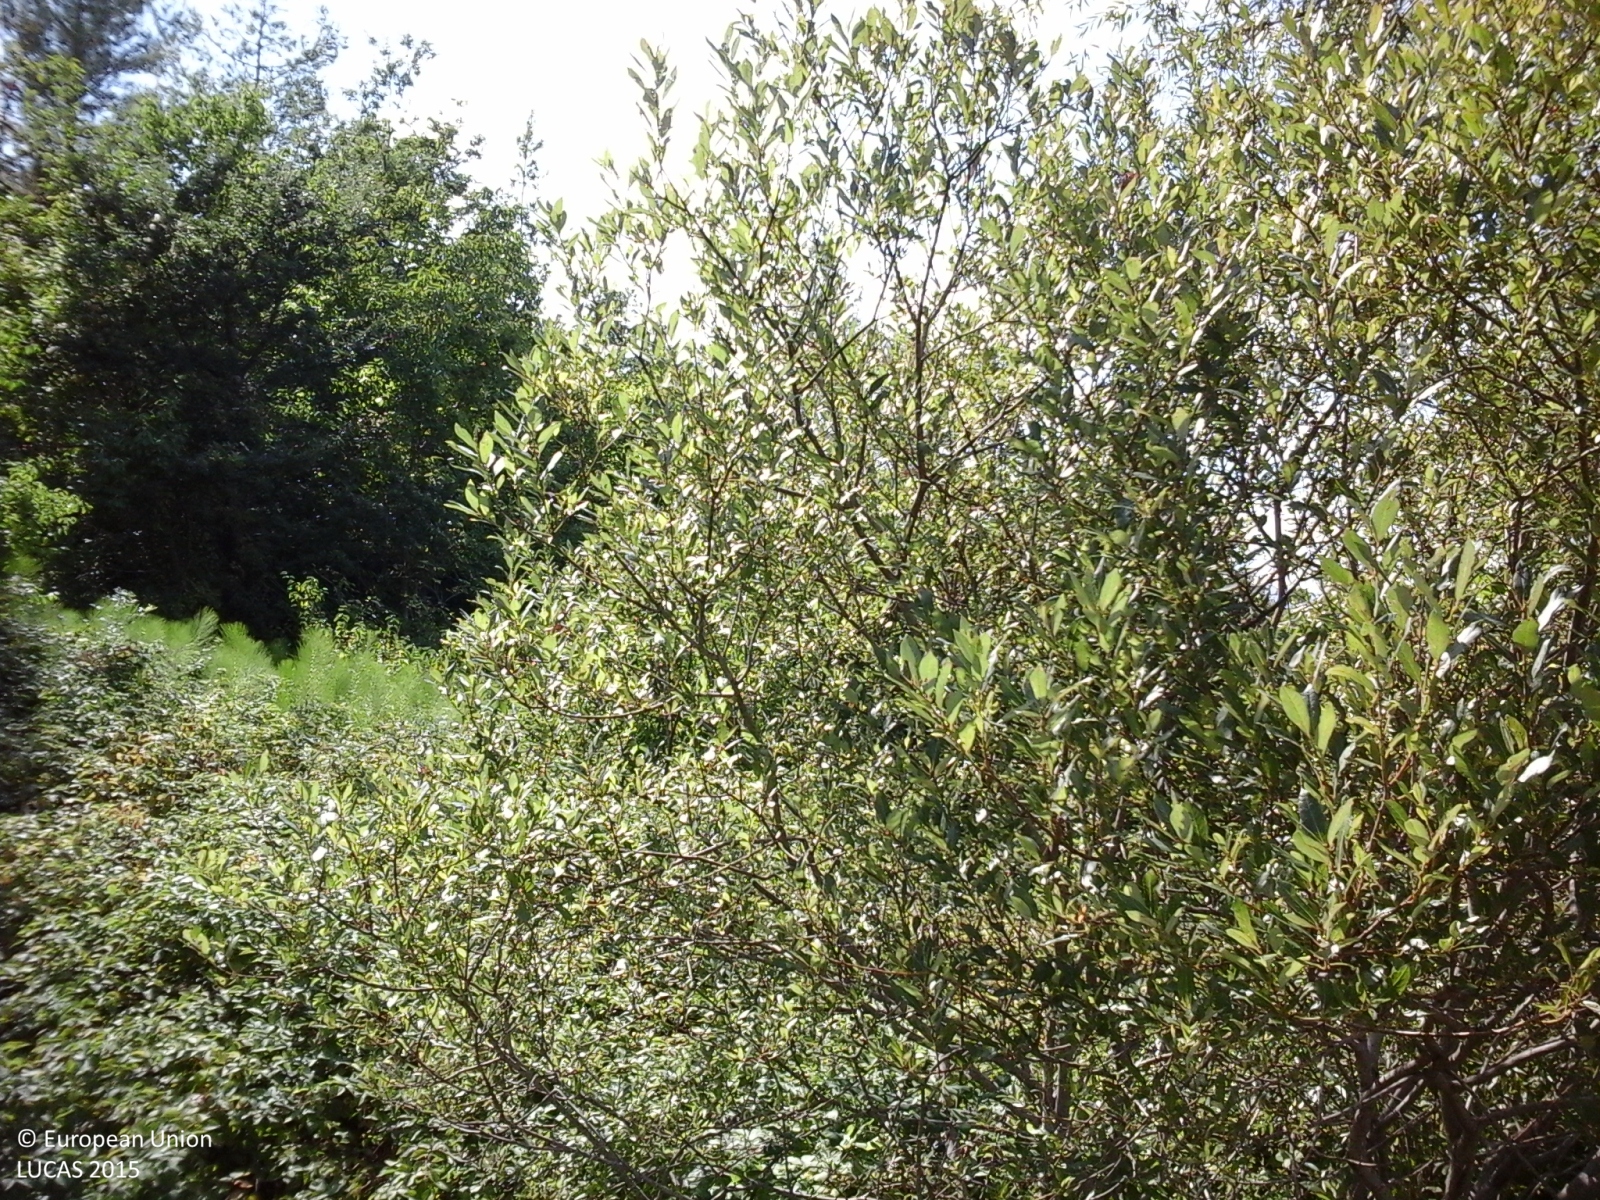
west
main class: Grassland
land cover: Spontaneously vegetated surfaces
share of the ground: > 75 %
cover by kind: herbaceous plants 100 %
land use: Fallow land
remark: Harvested field
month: August
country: IT
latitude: 43.0302
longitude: 13.4147
